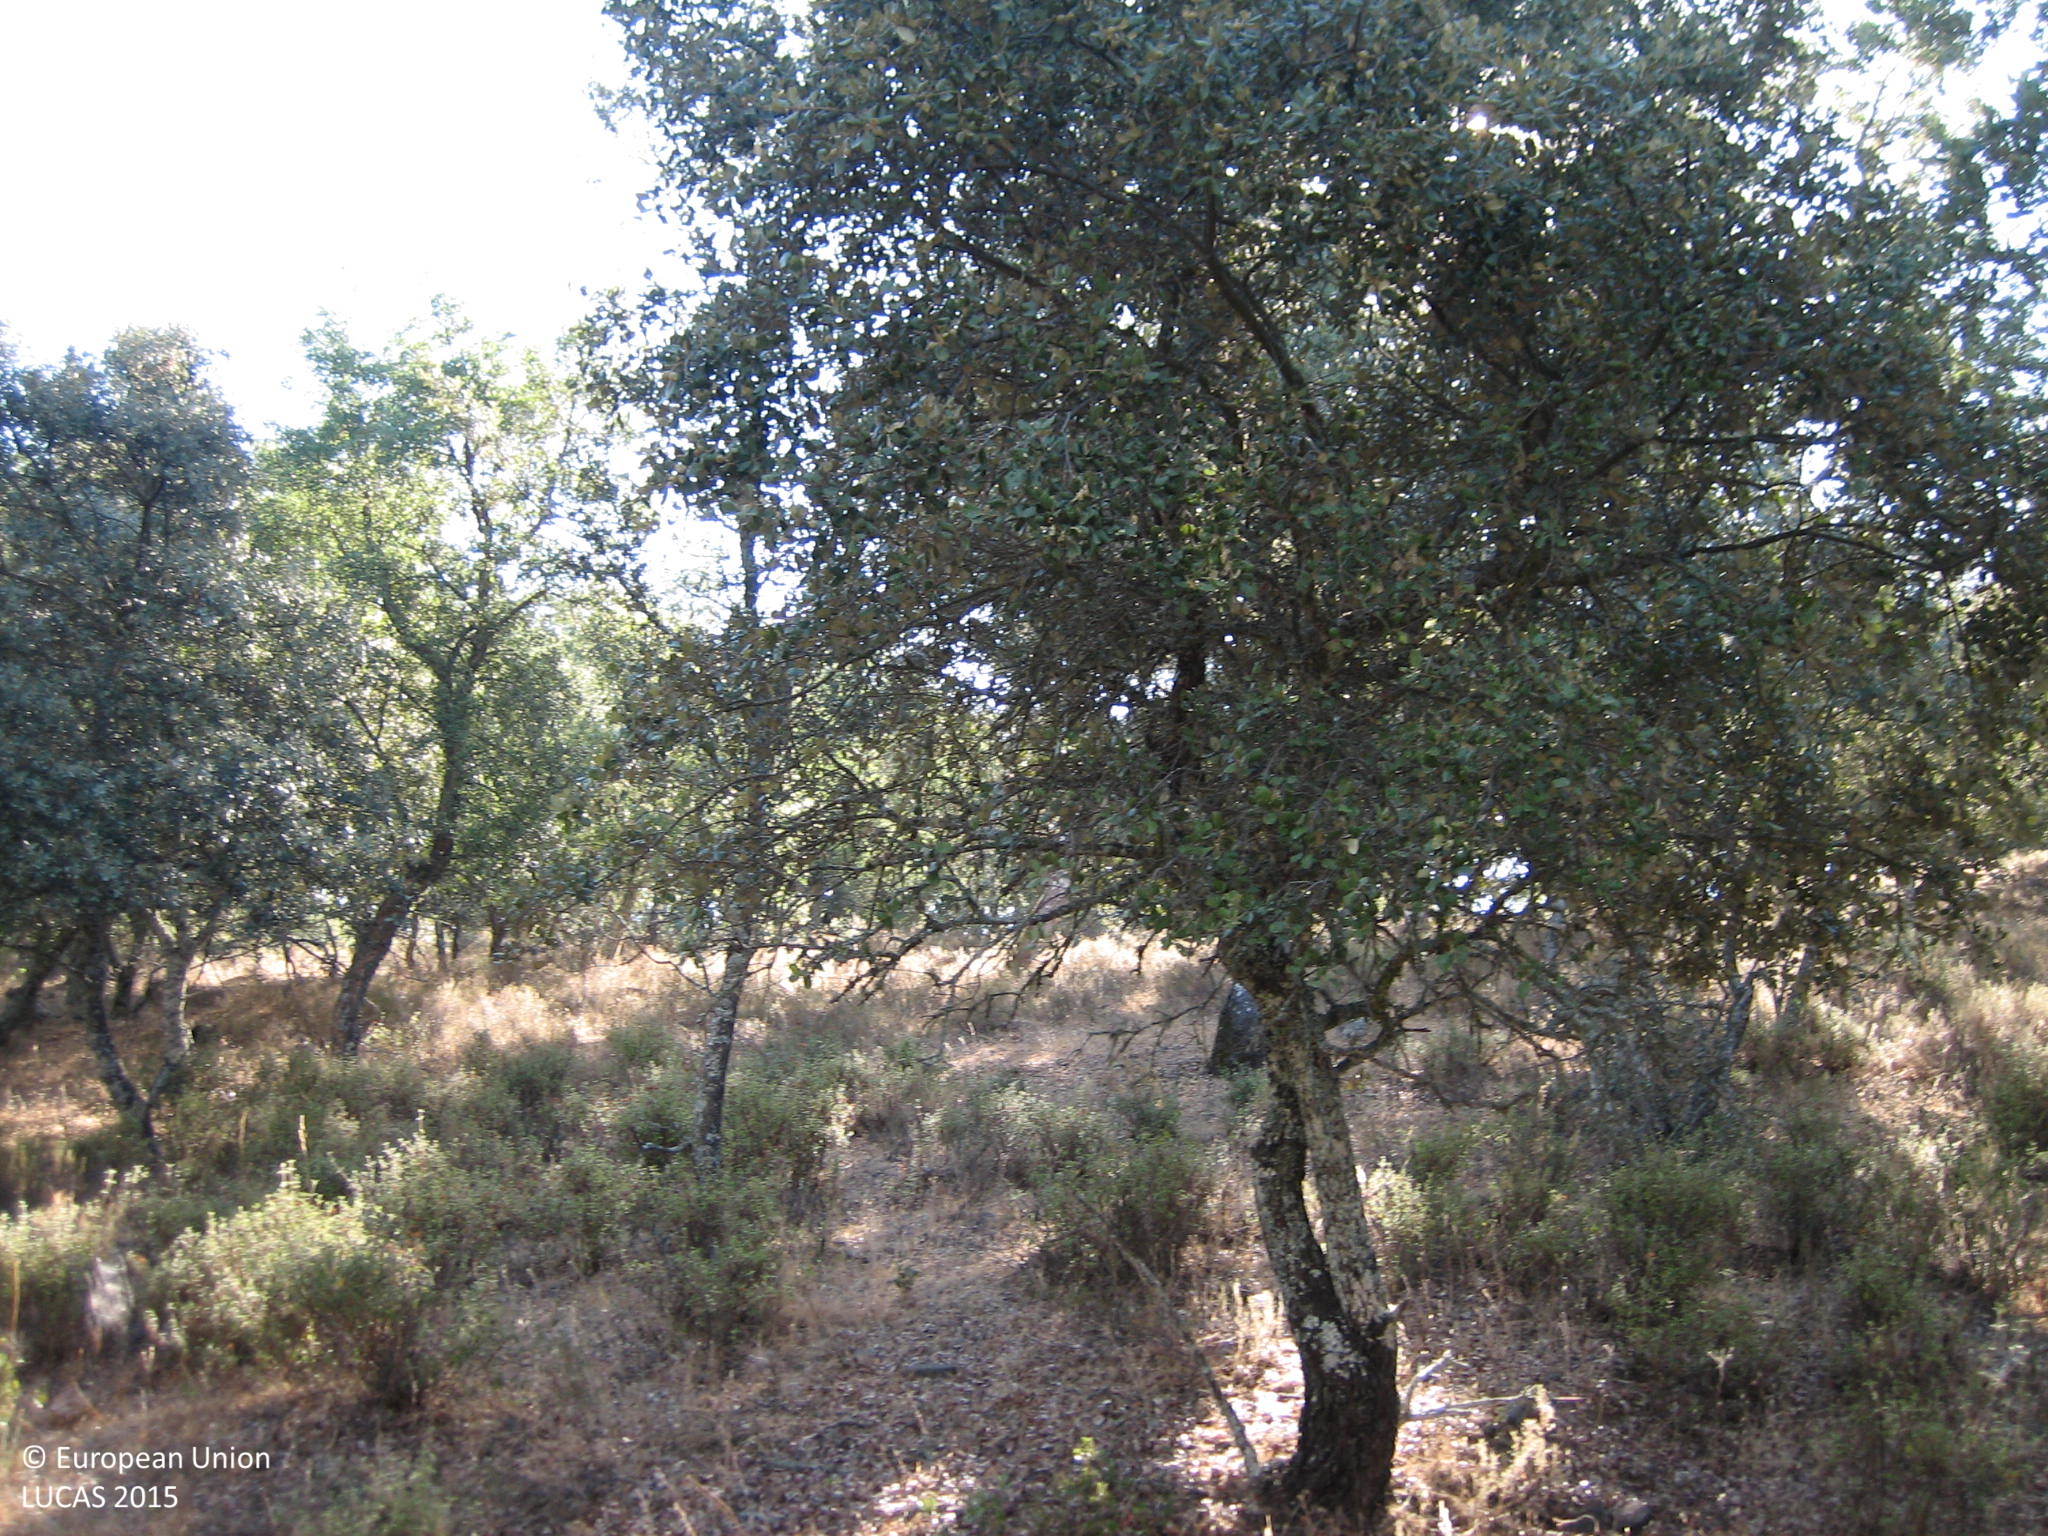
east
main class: Woodland
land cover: Broadleaved woodland
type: broadleaved evergreen forest
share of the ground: 50 - 75 %
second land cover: Shrubland without tree cover
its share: 25 - 50 %
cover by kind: broadleaved forest trees 60 %, shrubs 30 %, herbaceous plants 10 %
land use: Forestry
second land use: Agriculture (excluding fallow land and kitchen gardens)
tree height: > 5 m
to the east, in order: Broadleaved woodland; Shrubland without tree cover; Fences; Broadleaved woodland
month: August
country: ES
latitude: 38.0851
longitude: -6.2885
